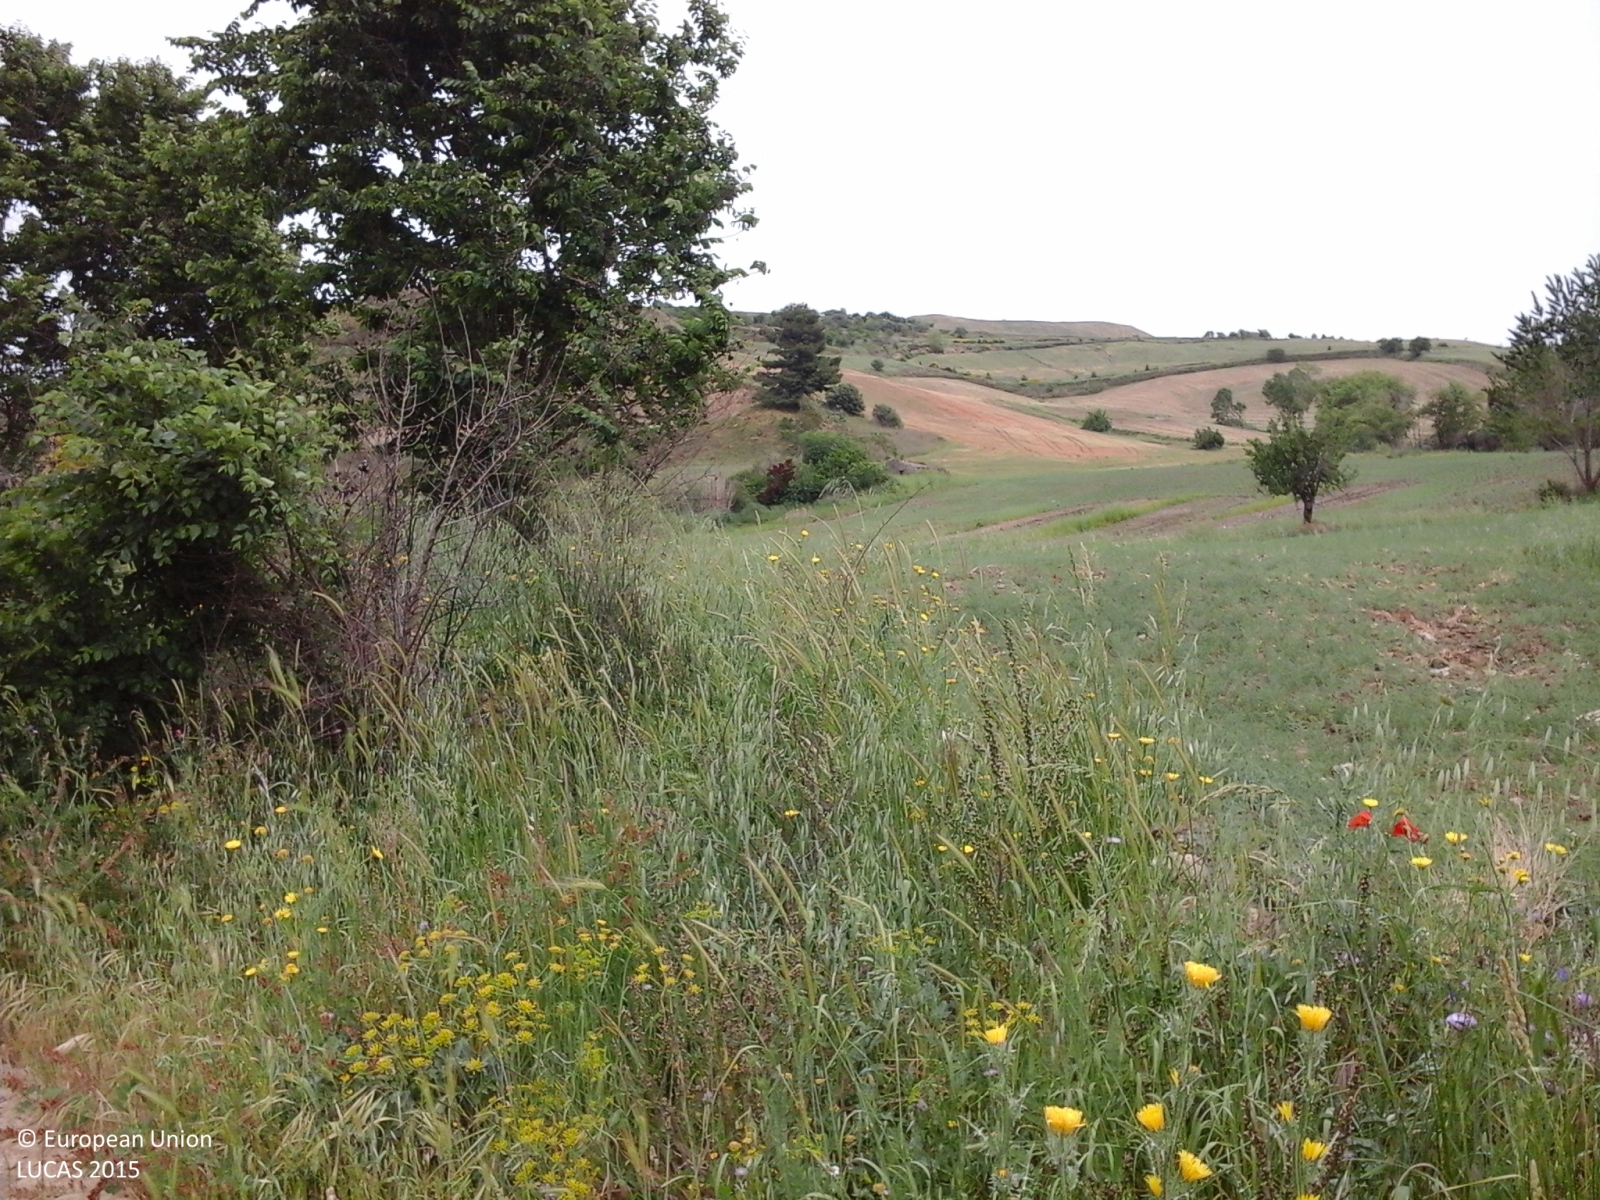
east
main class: Grassland
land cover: Spontaneously vegetated surfaces
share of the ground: > 75 %
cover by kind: herbaceous plants 100 %
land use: Agriculture (excluding fallow land and kitchen gardens)
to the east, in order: Spontaneously vegetated surfaces; Shrubland with sparse tree cover; Rivers and streams; Shrubland with sparse tree cover; Tracks; Dry pulses; Shrubland with sparse tree cover; Dry pulses; Tracks; Durum wheat
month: May
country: IT
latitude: 37.6645
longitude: 13.9727
